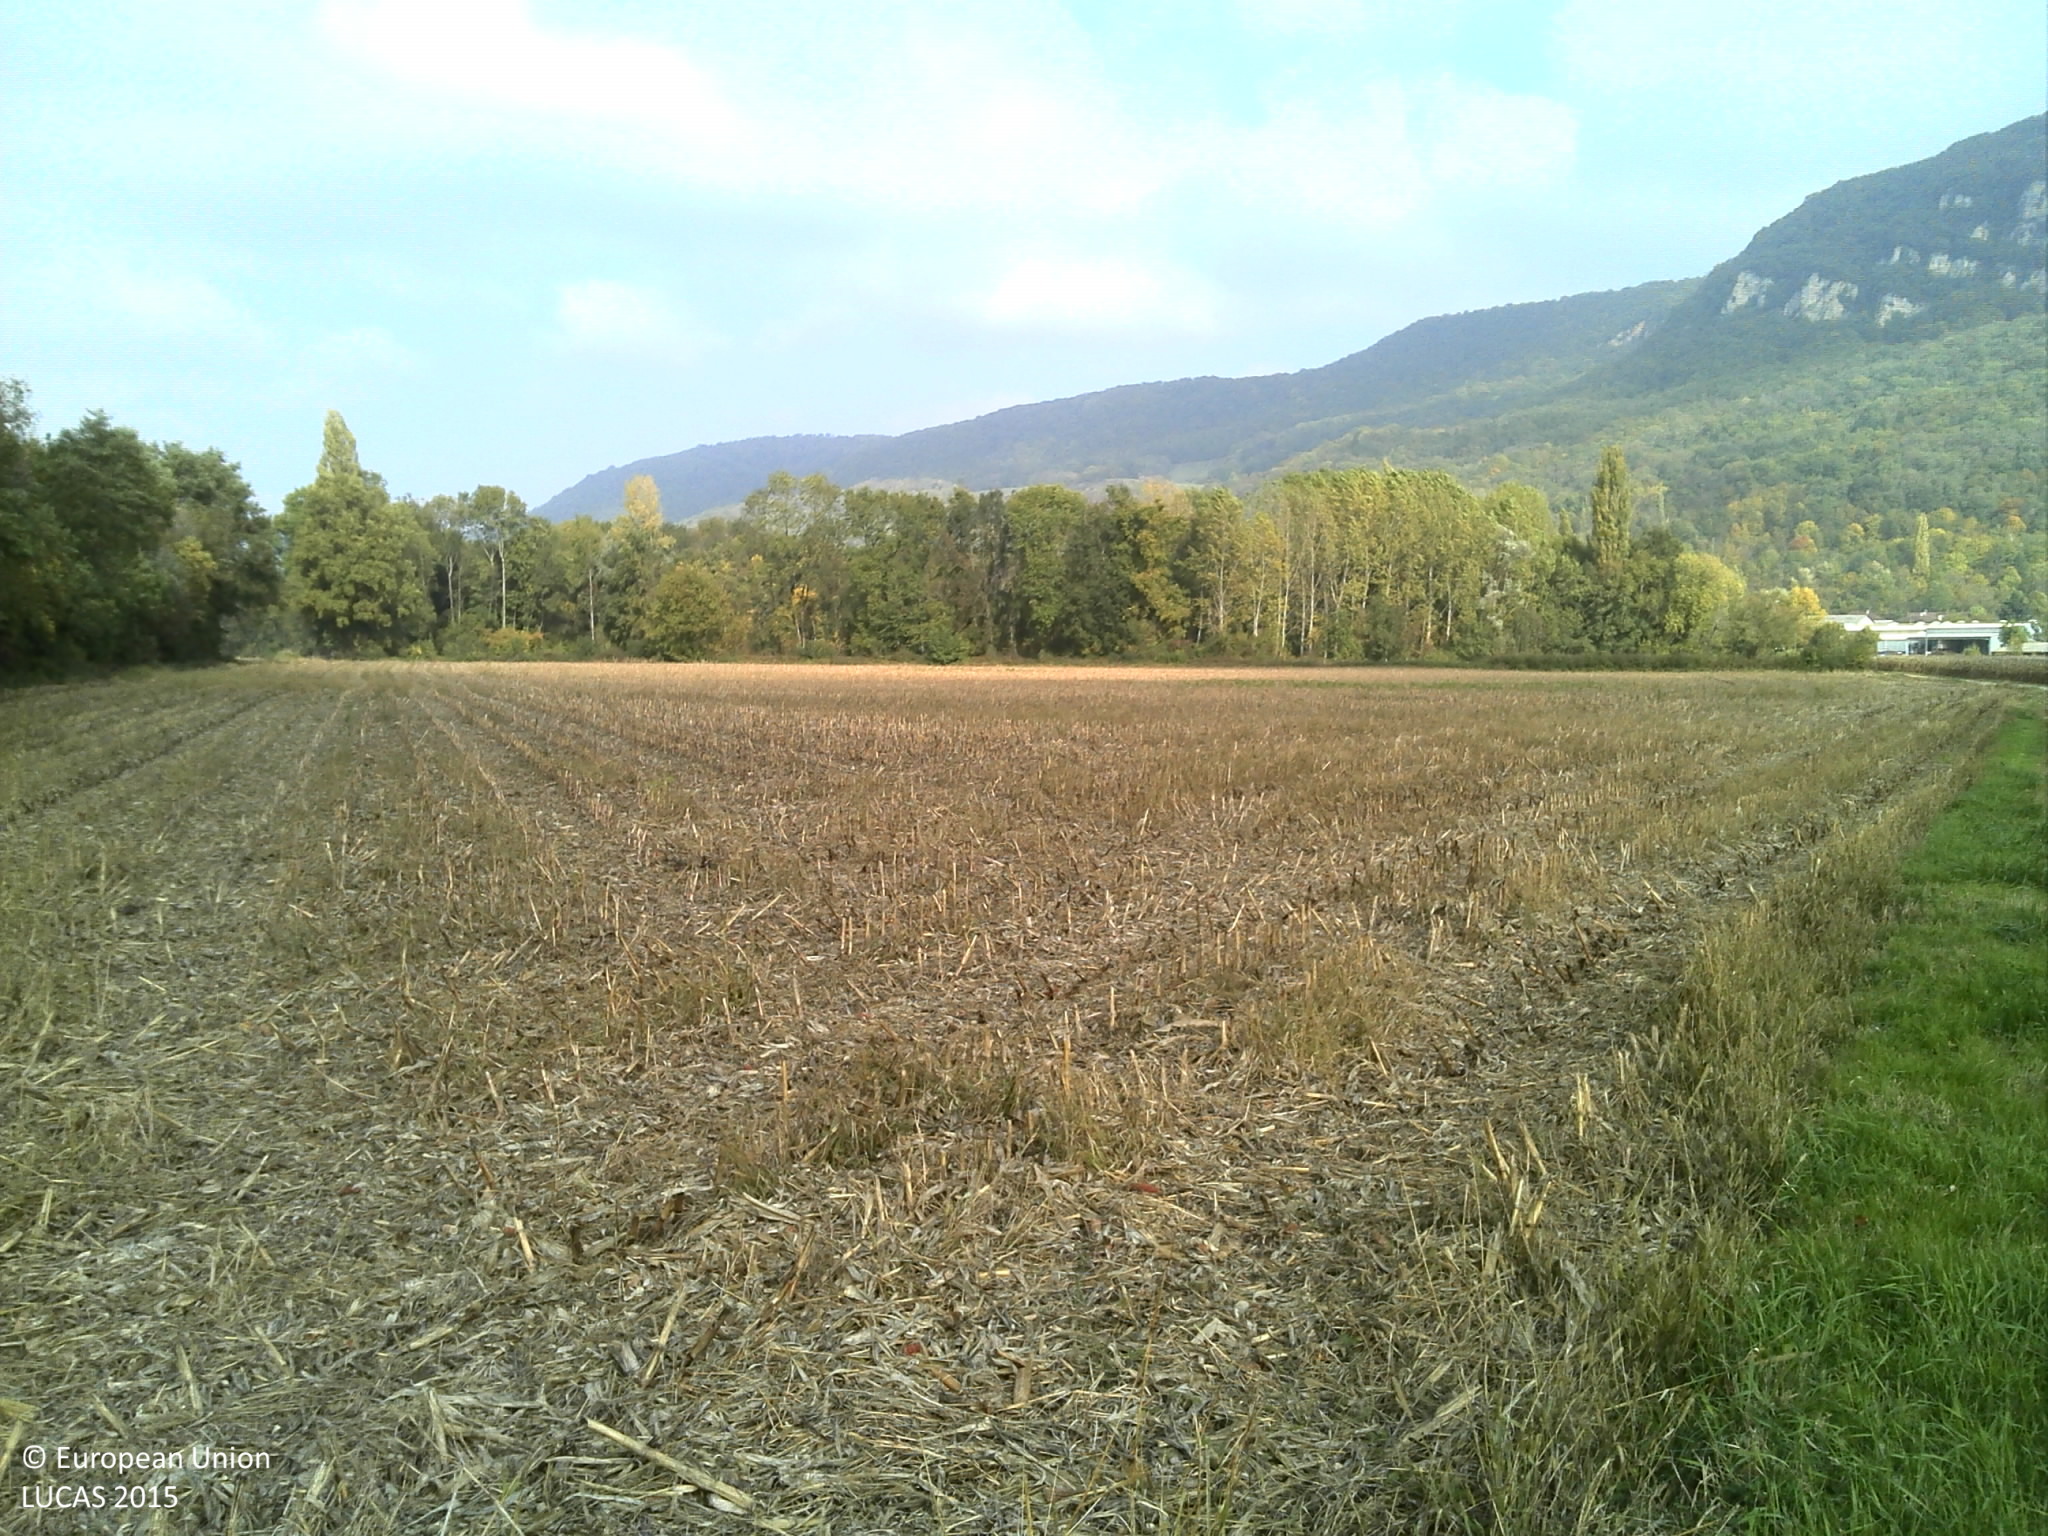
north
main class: Cropland
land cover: Maize
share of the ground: < 10 %
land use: Agriculture (excluding fallow land and kitchen gardens)
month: October
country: FR
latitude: 45.8893
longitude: 5.3516
